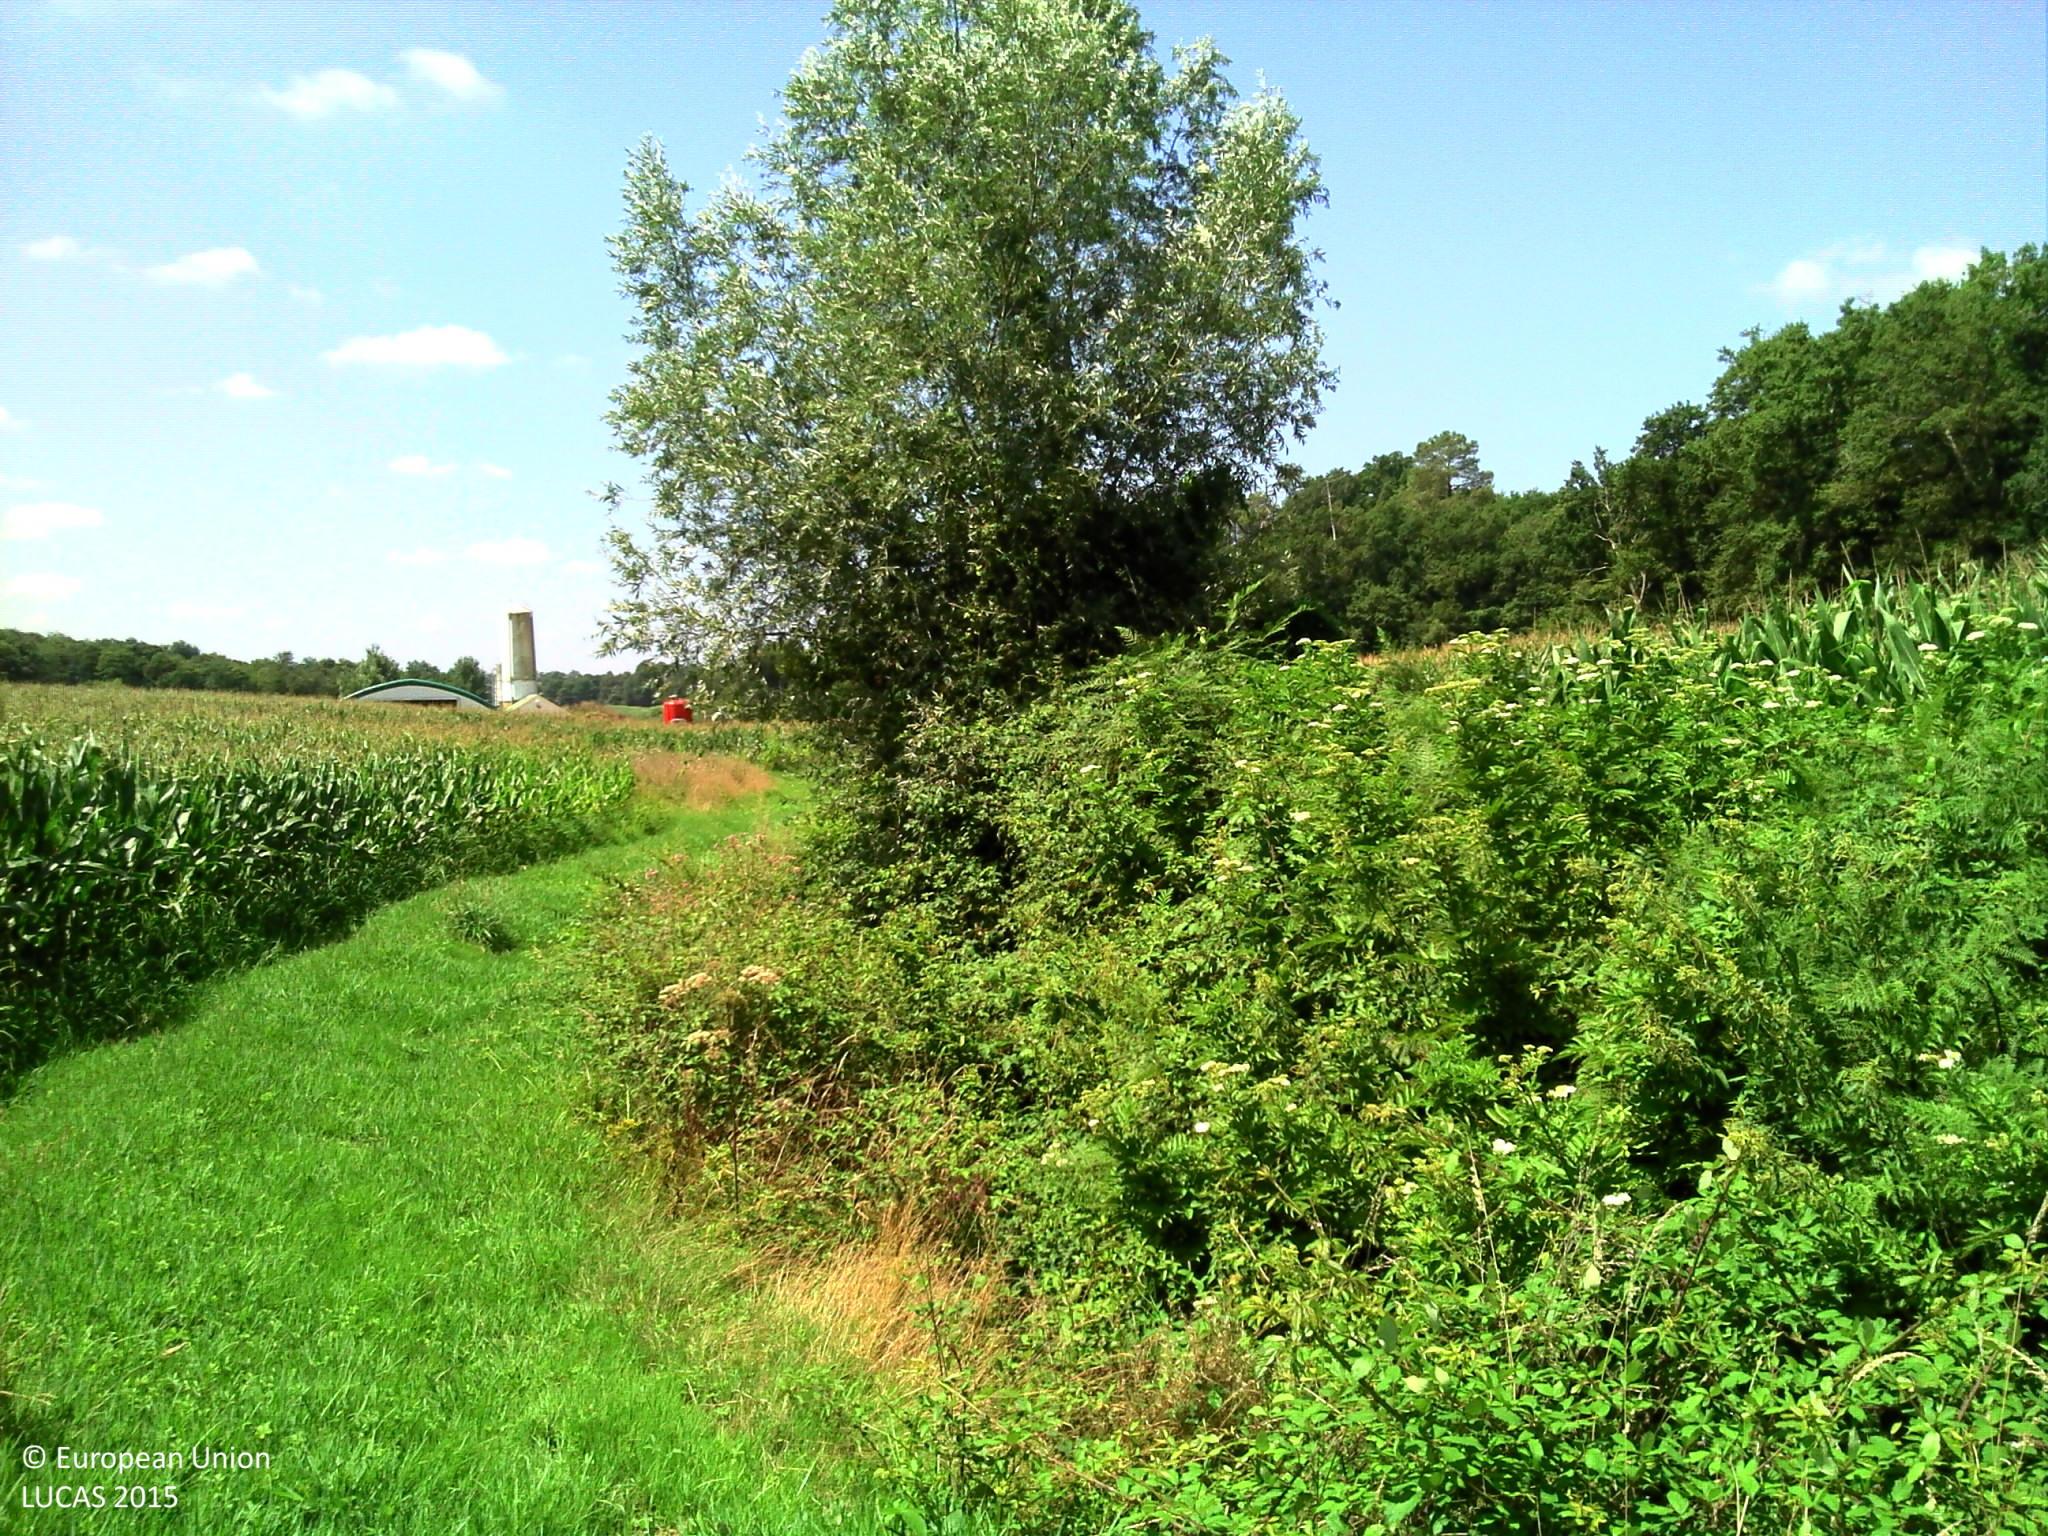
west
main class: Cropland
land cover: Maize
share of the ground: > 75 %
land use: Agriculture (excluding fallow land and kitchen gardens)
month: August
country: FR
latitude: 43.7076
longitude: -0.4972
